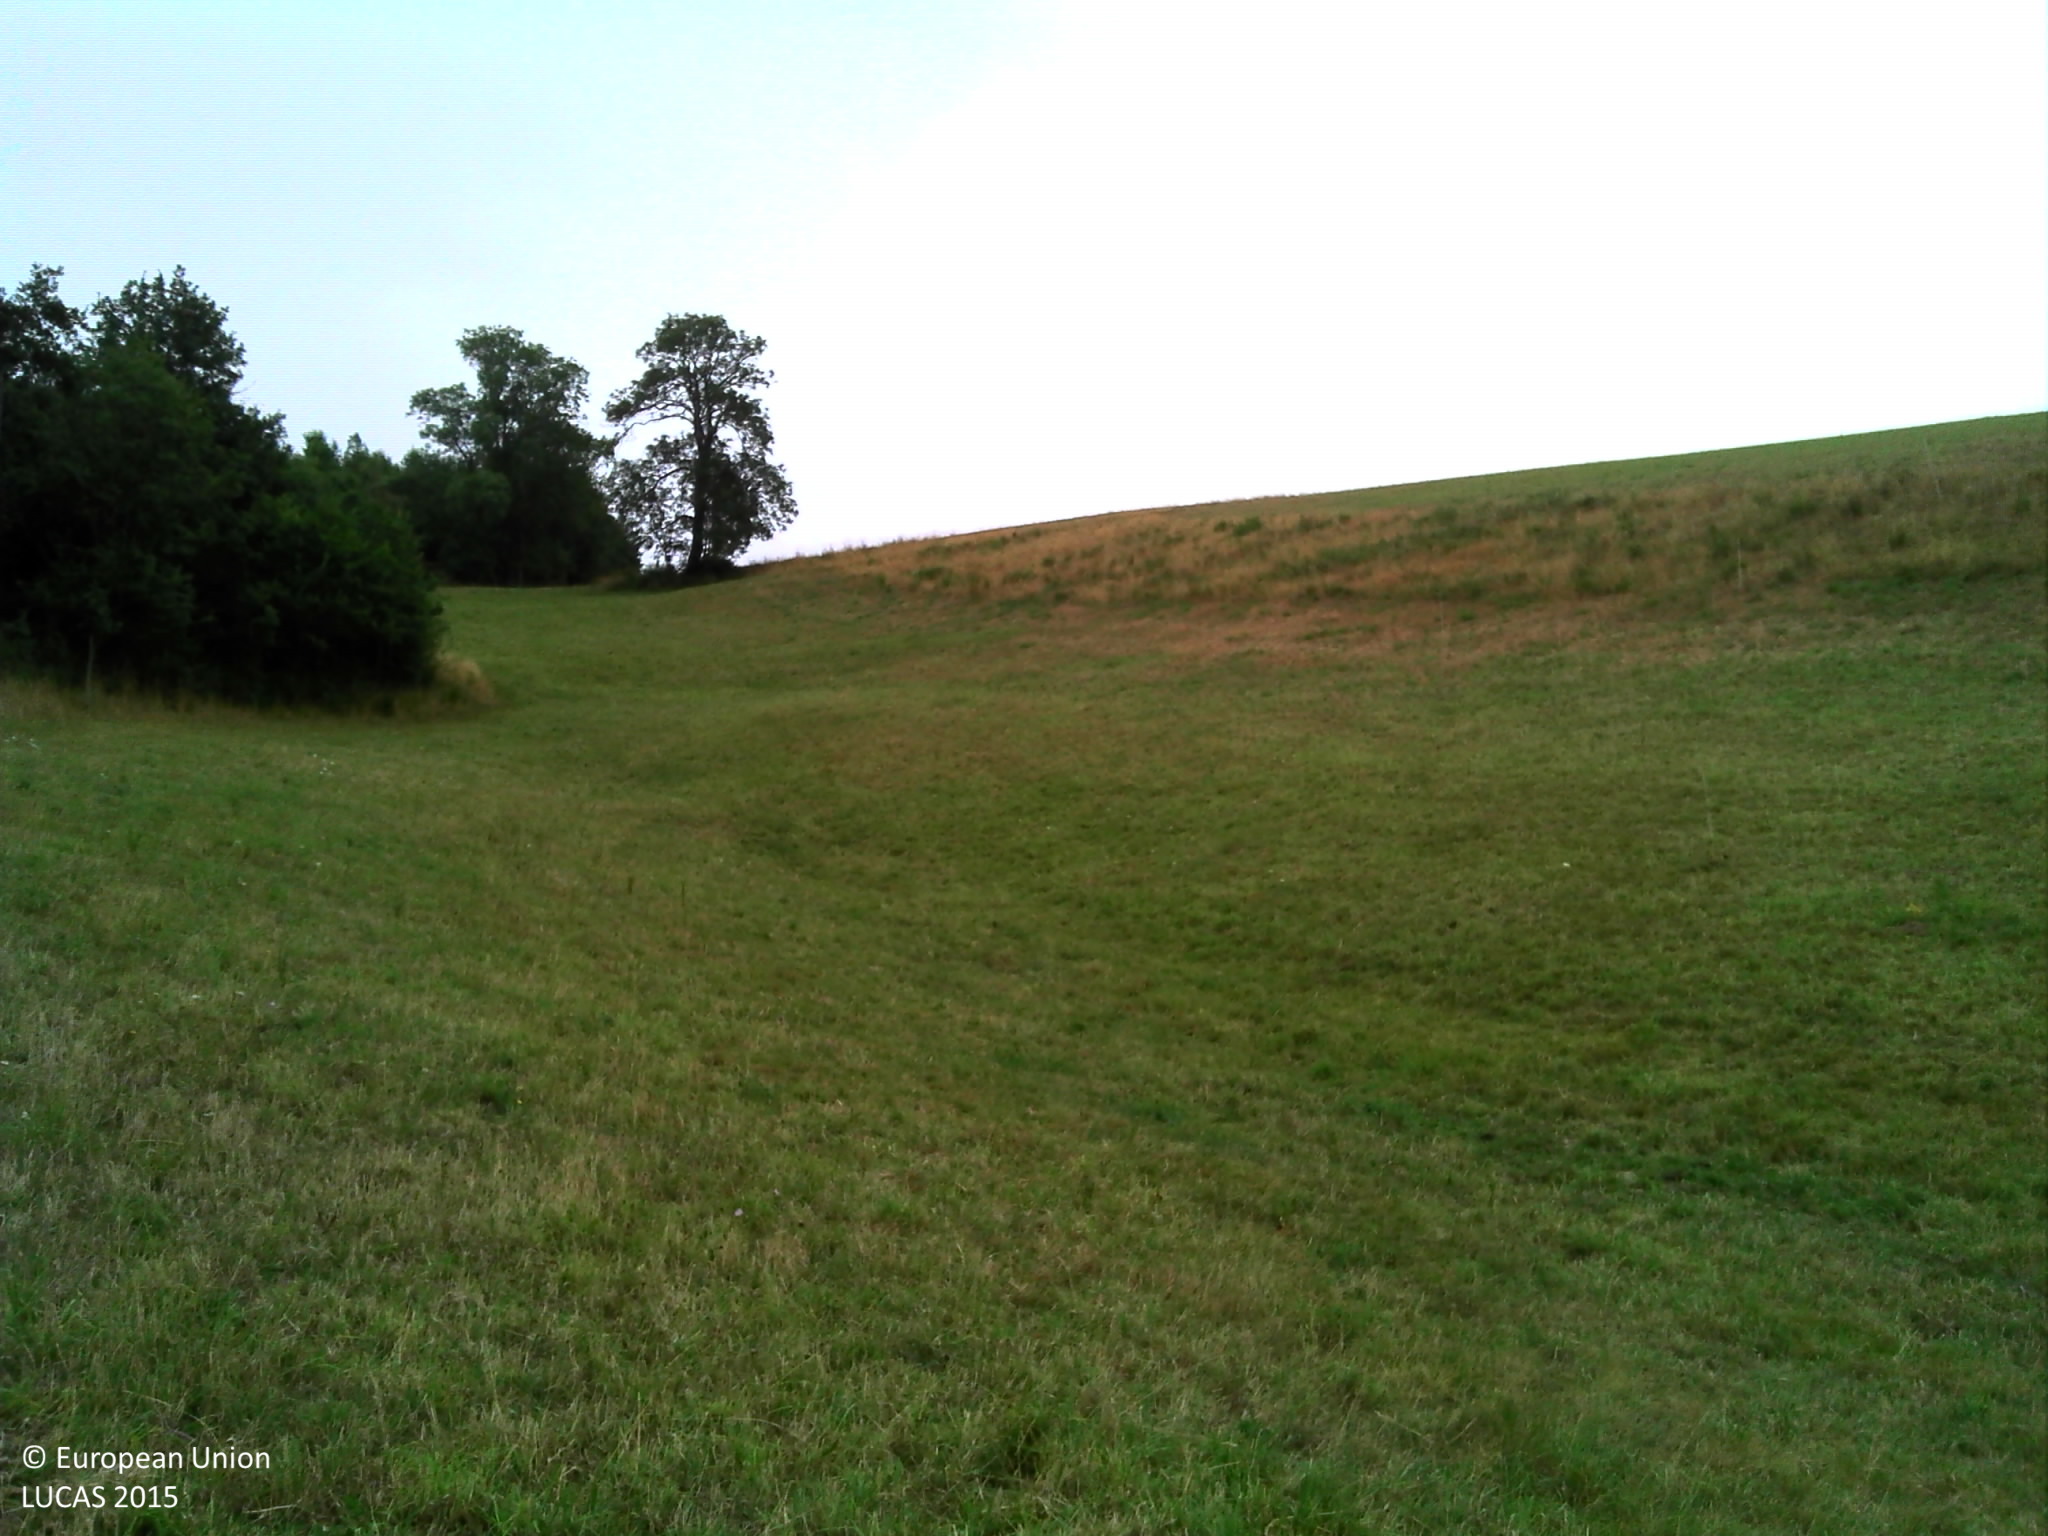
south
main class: Grassland
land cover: Grassland without tree/shrub cover
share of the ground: > 75 %
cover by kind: herbaceous plants 90 %, lichens and mosses 5 %, unconsolidated bare surface 5 %
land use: Agriculture (excluding fallow land and kitchen gardens)
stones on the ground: < 10 %
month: July
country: FR
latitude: 45.4318
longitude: 4.1364
